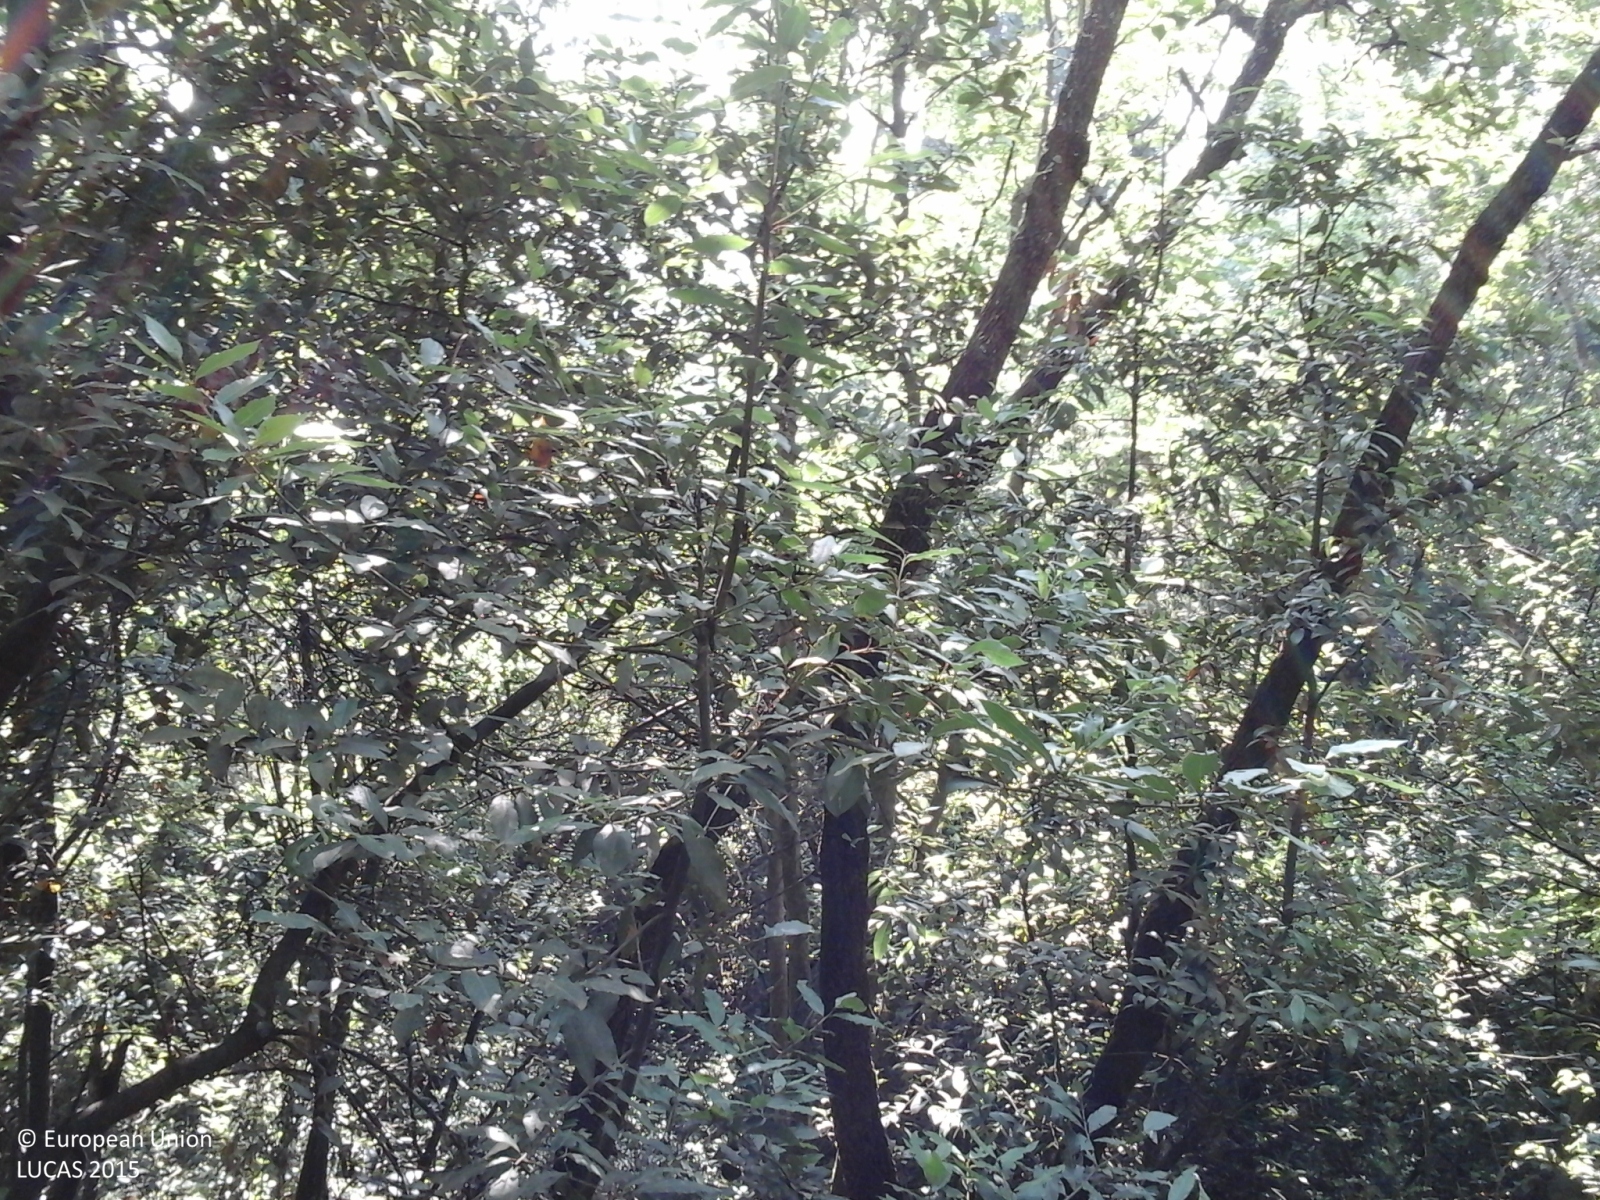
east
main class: Woodland
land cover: Other mixed woodland
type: thermophilous deciduous forest
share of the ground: > 75 %
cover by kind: broadleaved forest trees 50 %, coniferous forest trees 40 %, shrubs 10 %
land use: Forestry
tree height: > 5 m
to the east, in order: Other mixed woodland; Lines of trees; Tracks; Lines of trees; Broadleaved woodland; Olive groves; Dry stone walls; Paved roads, cycling and walking lanes; Grass margins; Olive groves; Shruby margins; Ditches and canals; Shruby margins; Spontaneously vegetated surfaces; Lines of trees; Artificial constructions; Lines of trees; Ditches and canals; Artificial constructions in urban areas; Grassland without tree/shrub cover; Fences; Grassland without tree/shrub cover; Tomatoes
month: June
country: IT
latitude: 43.8751
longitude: 11.1544
